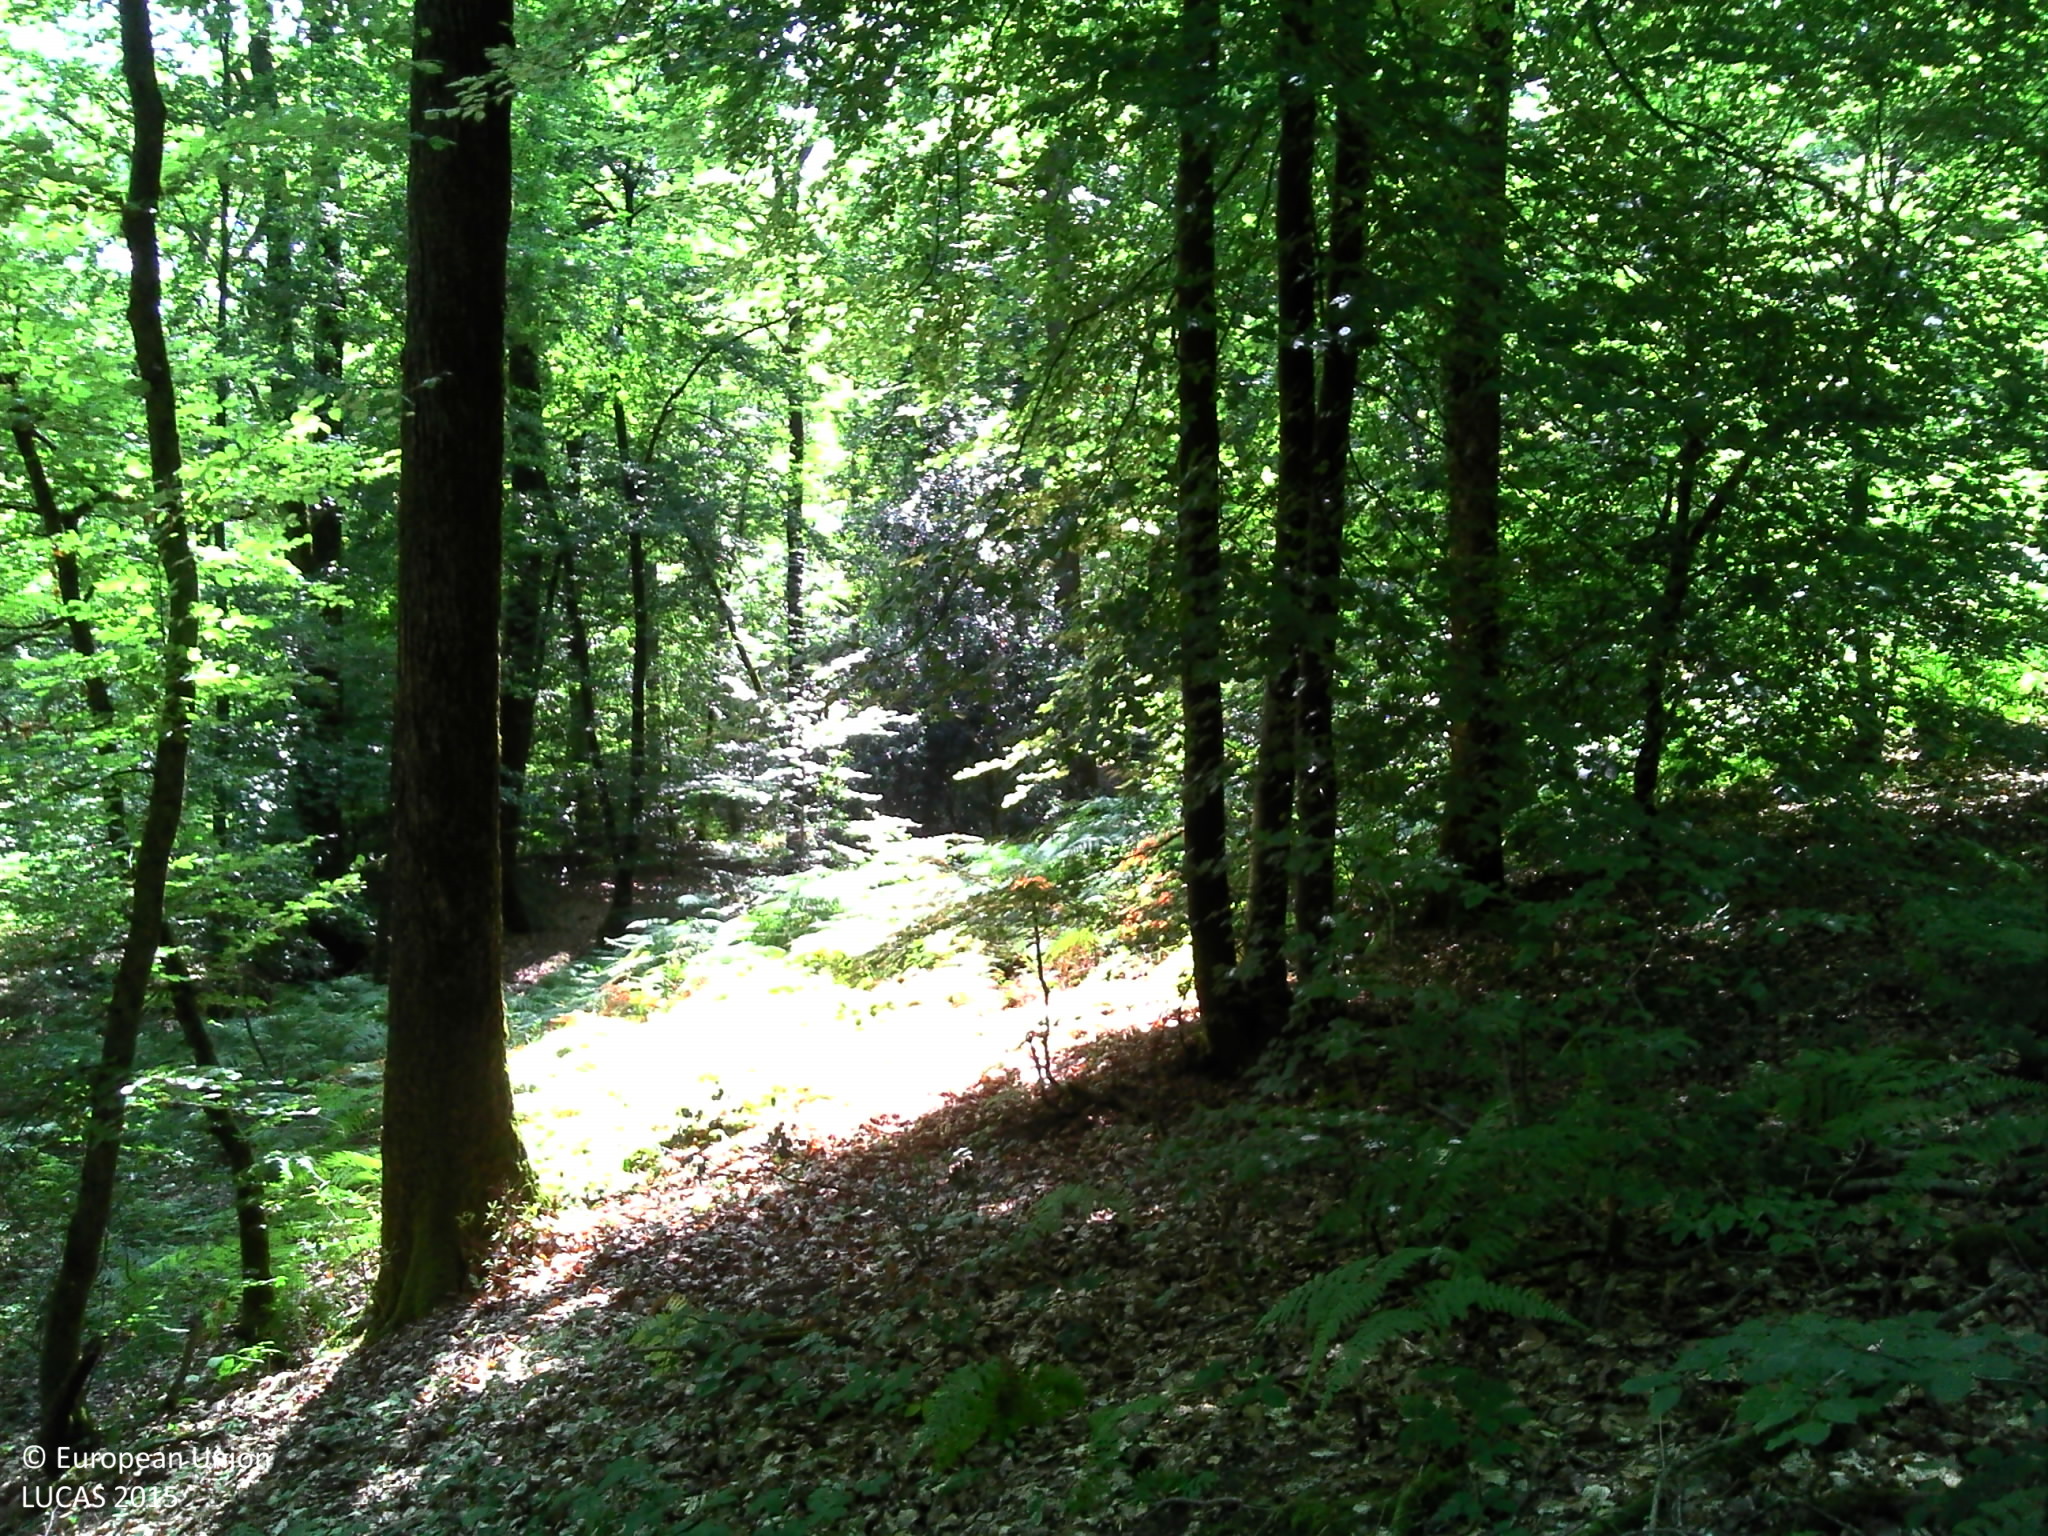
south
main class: Woodland
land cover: Broadleaved woodland
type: acidophilous oak and oak-birch forest
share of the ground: > 75 %
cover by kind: broadleaved forest trees 40 %, herbaceous plants 30 %, lichens and mosses 10 %, unconsolidated bare surface 10 %, consolidated bare surface 5 %
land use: Forestry
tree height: > 5 m
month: August
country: FR
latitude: 49.1335
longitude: 4.1707
